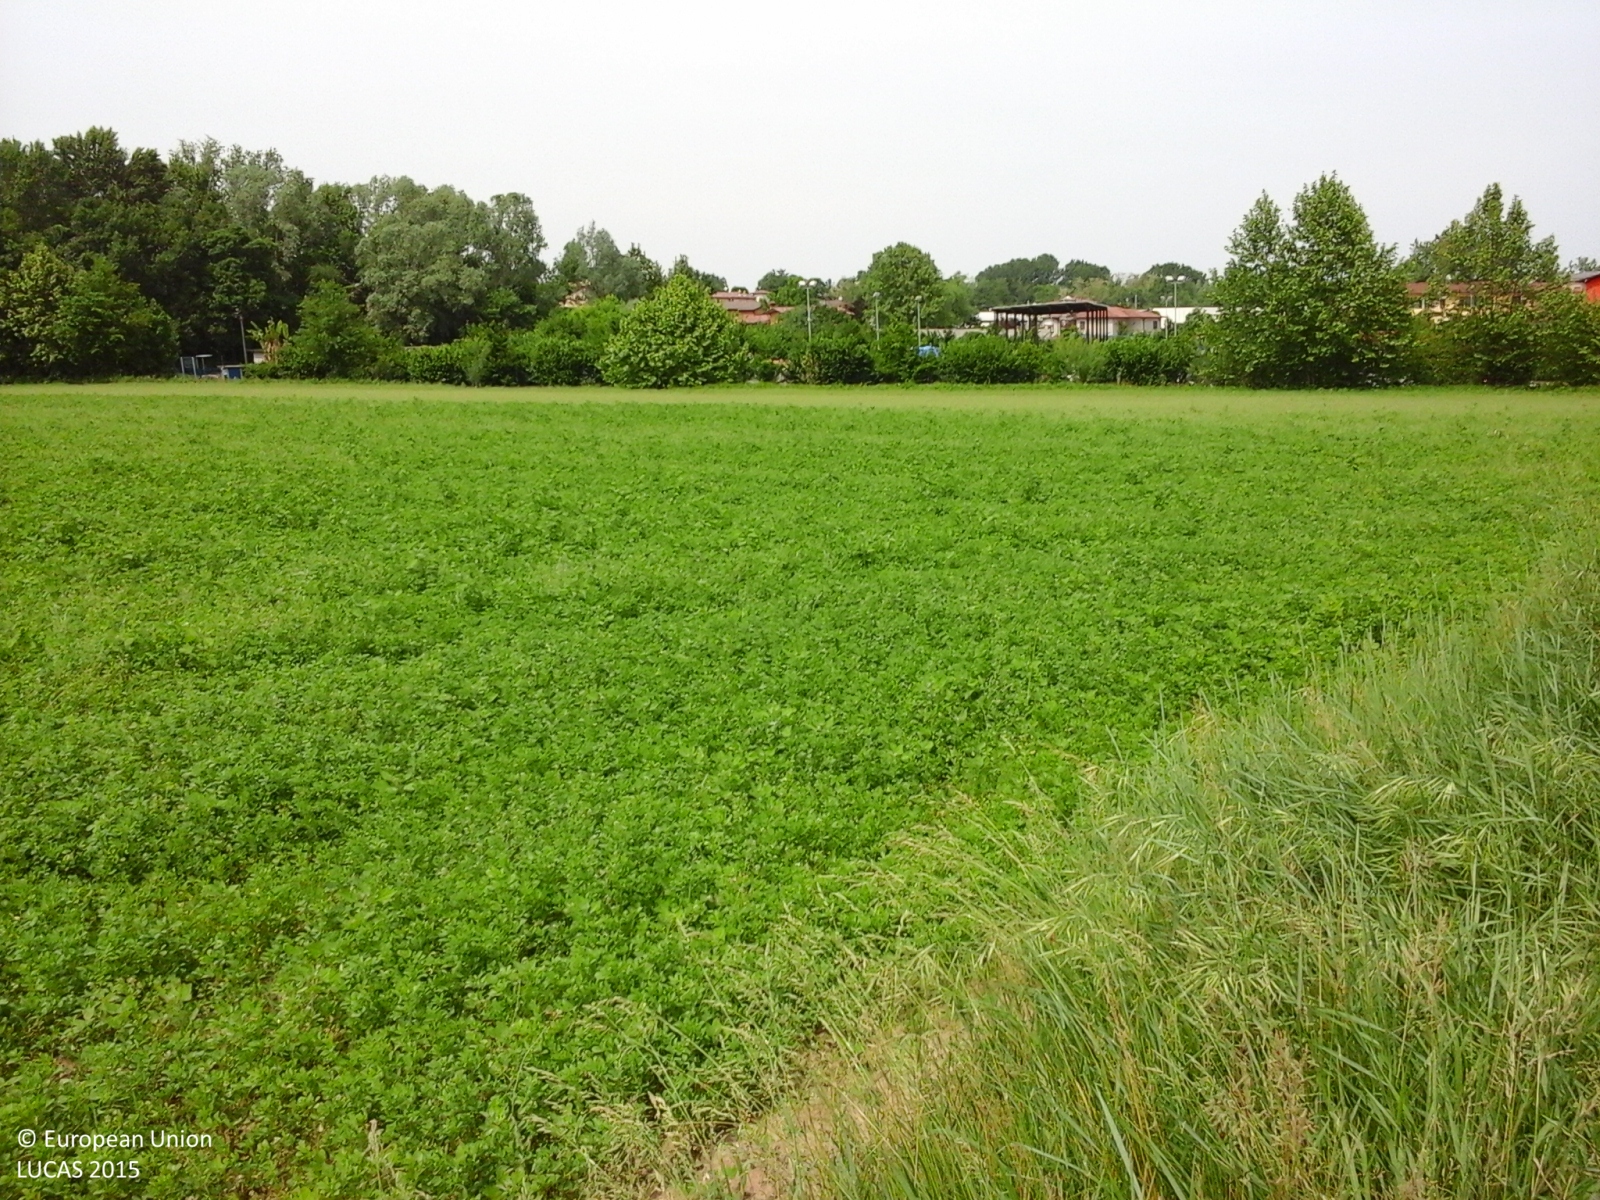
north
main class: Cropland
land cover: Lucerne
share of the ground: > 75 %
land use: Agriculture (excluding fallow land and kitchen gardens)
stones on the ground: < 10 %
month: May
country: IT
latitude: 45.3061
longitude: 10.0127
